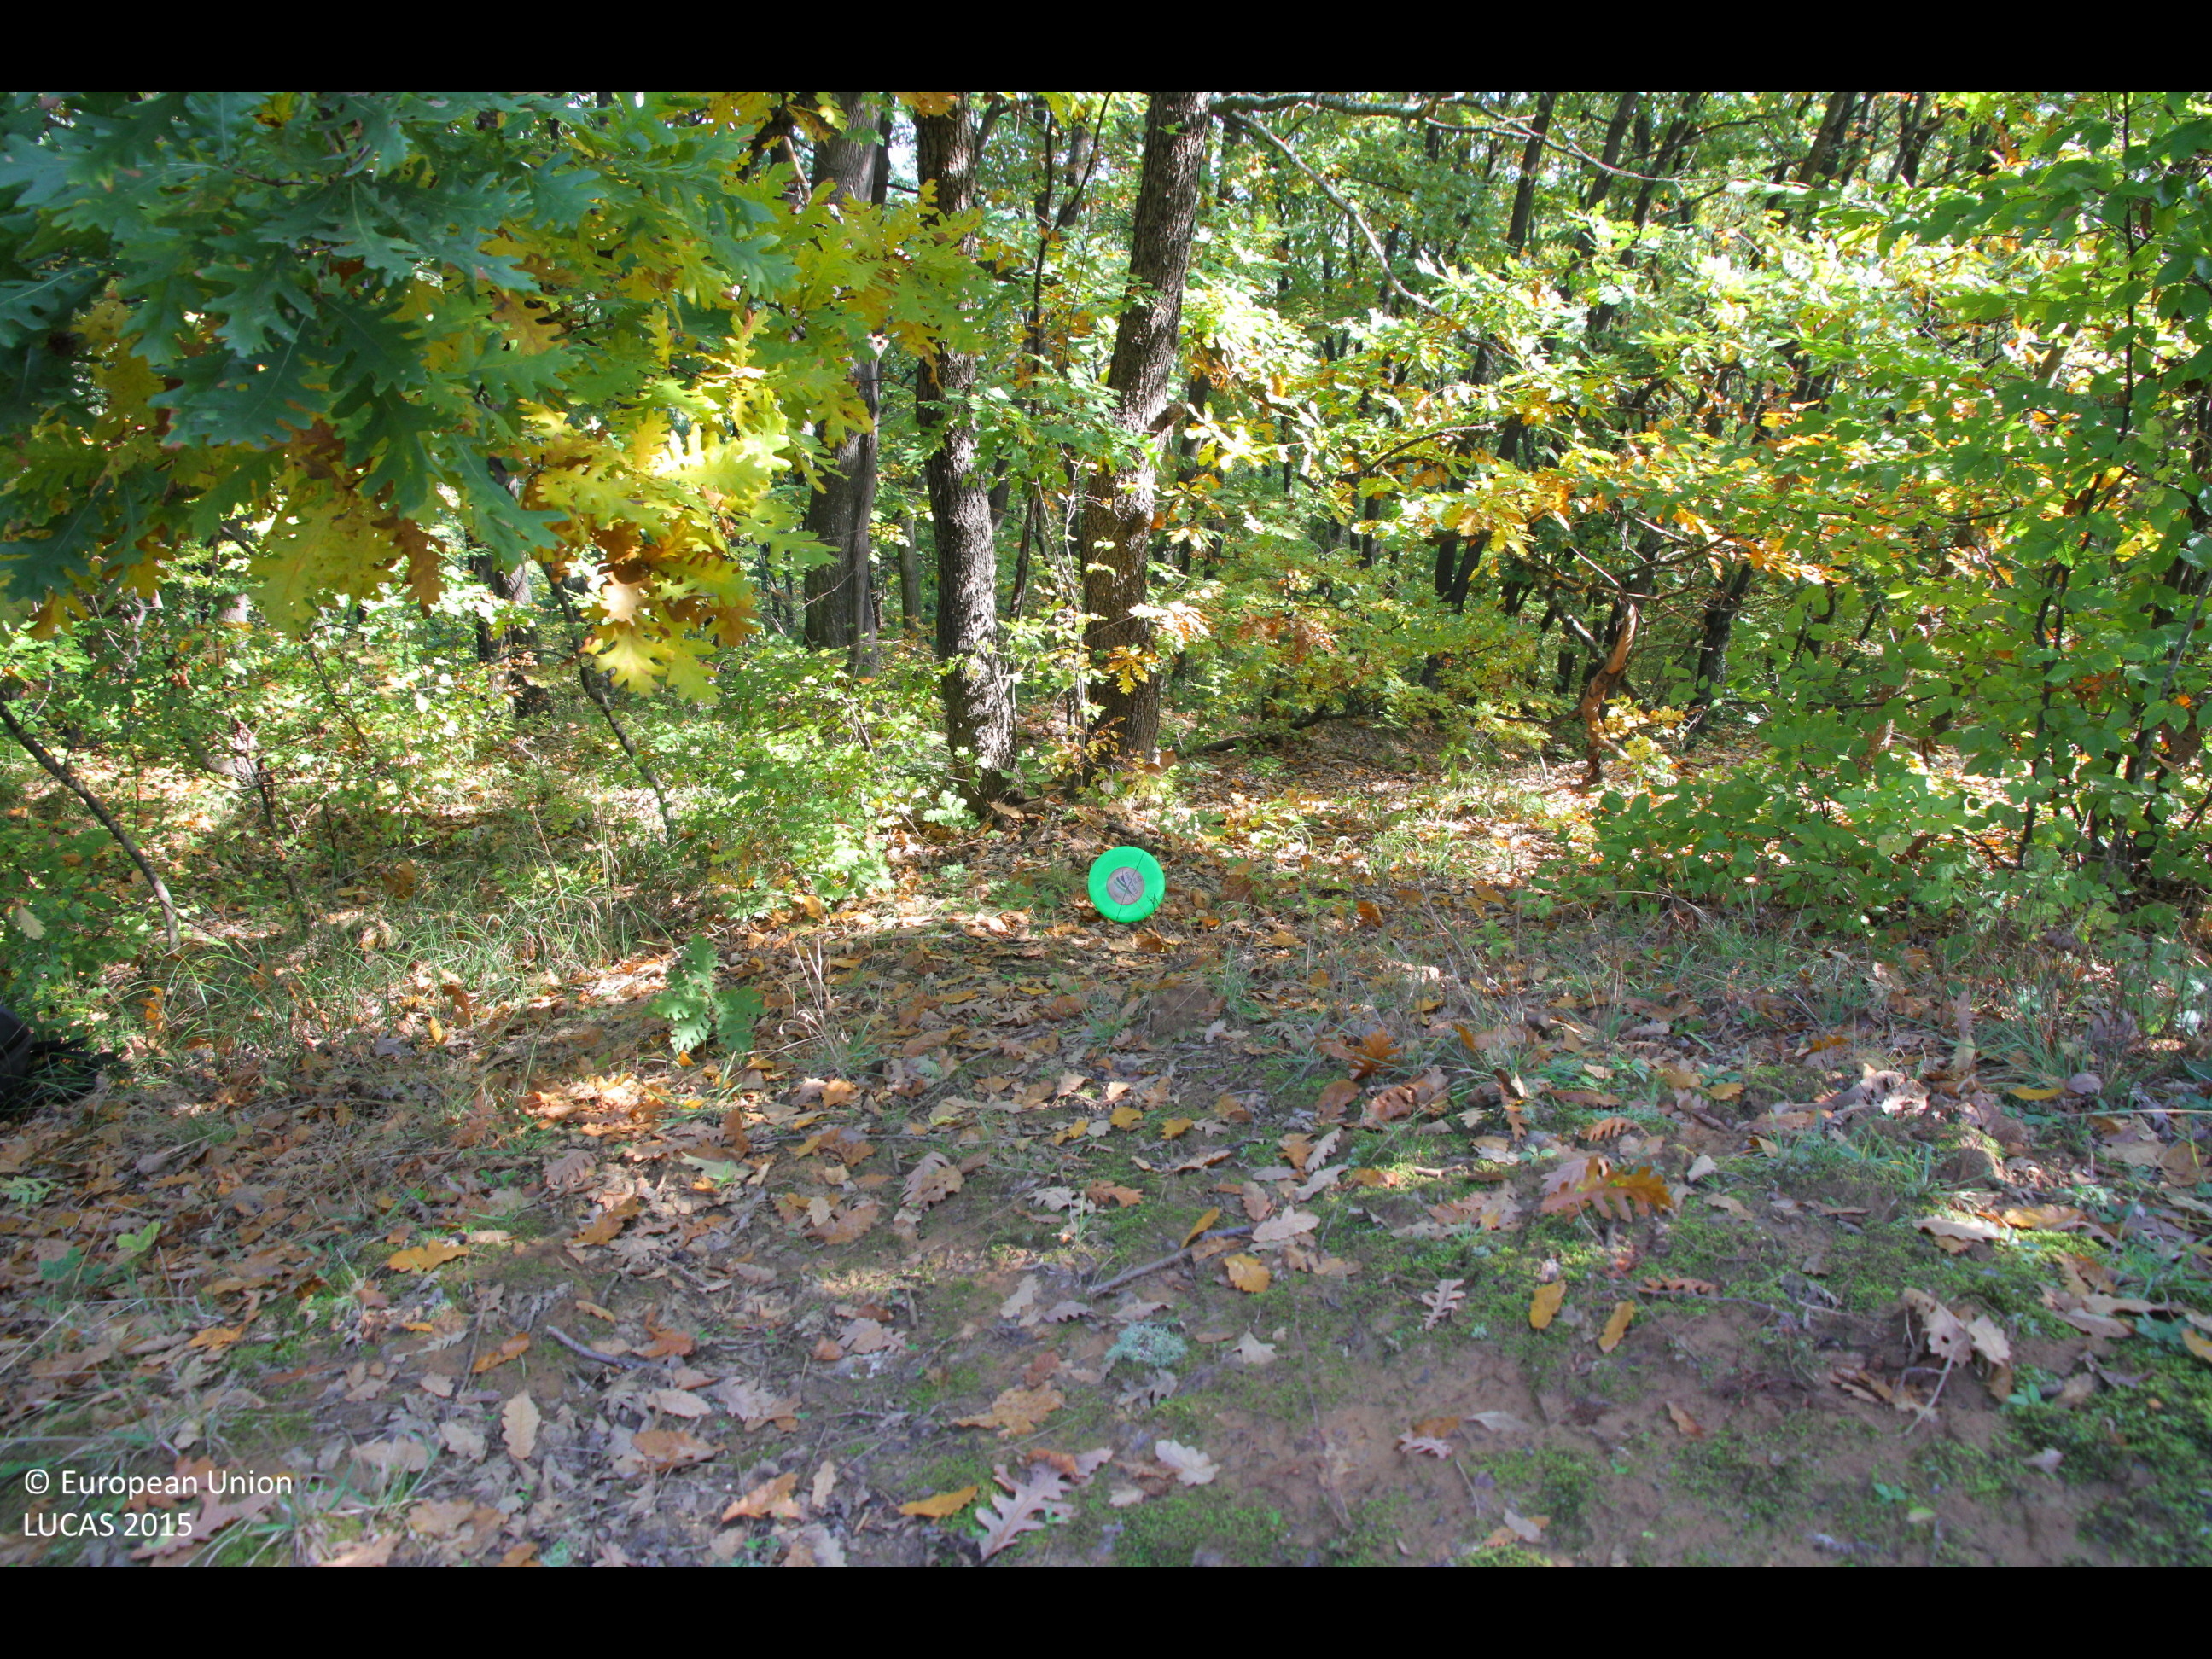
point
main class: Woodland
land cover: Broadleaved woodland
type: mesophytic deciduous forest
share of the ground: > 75 %
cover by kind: broadleaved forest trees 100 %
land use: Forestry
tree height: > 5 m
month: October
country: BG
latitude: 42.9986
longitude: 26.9517
